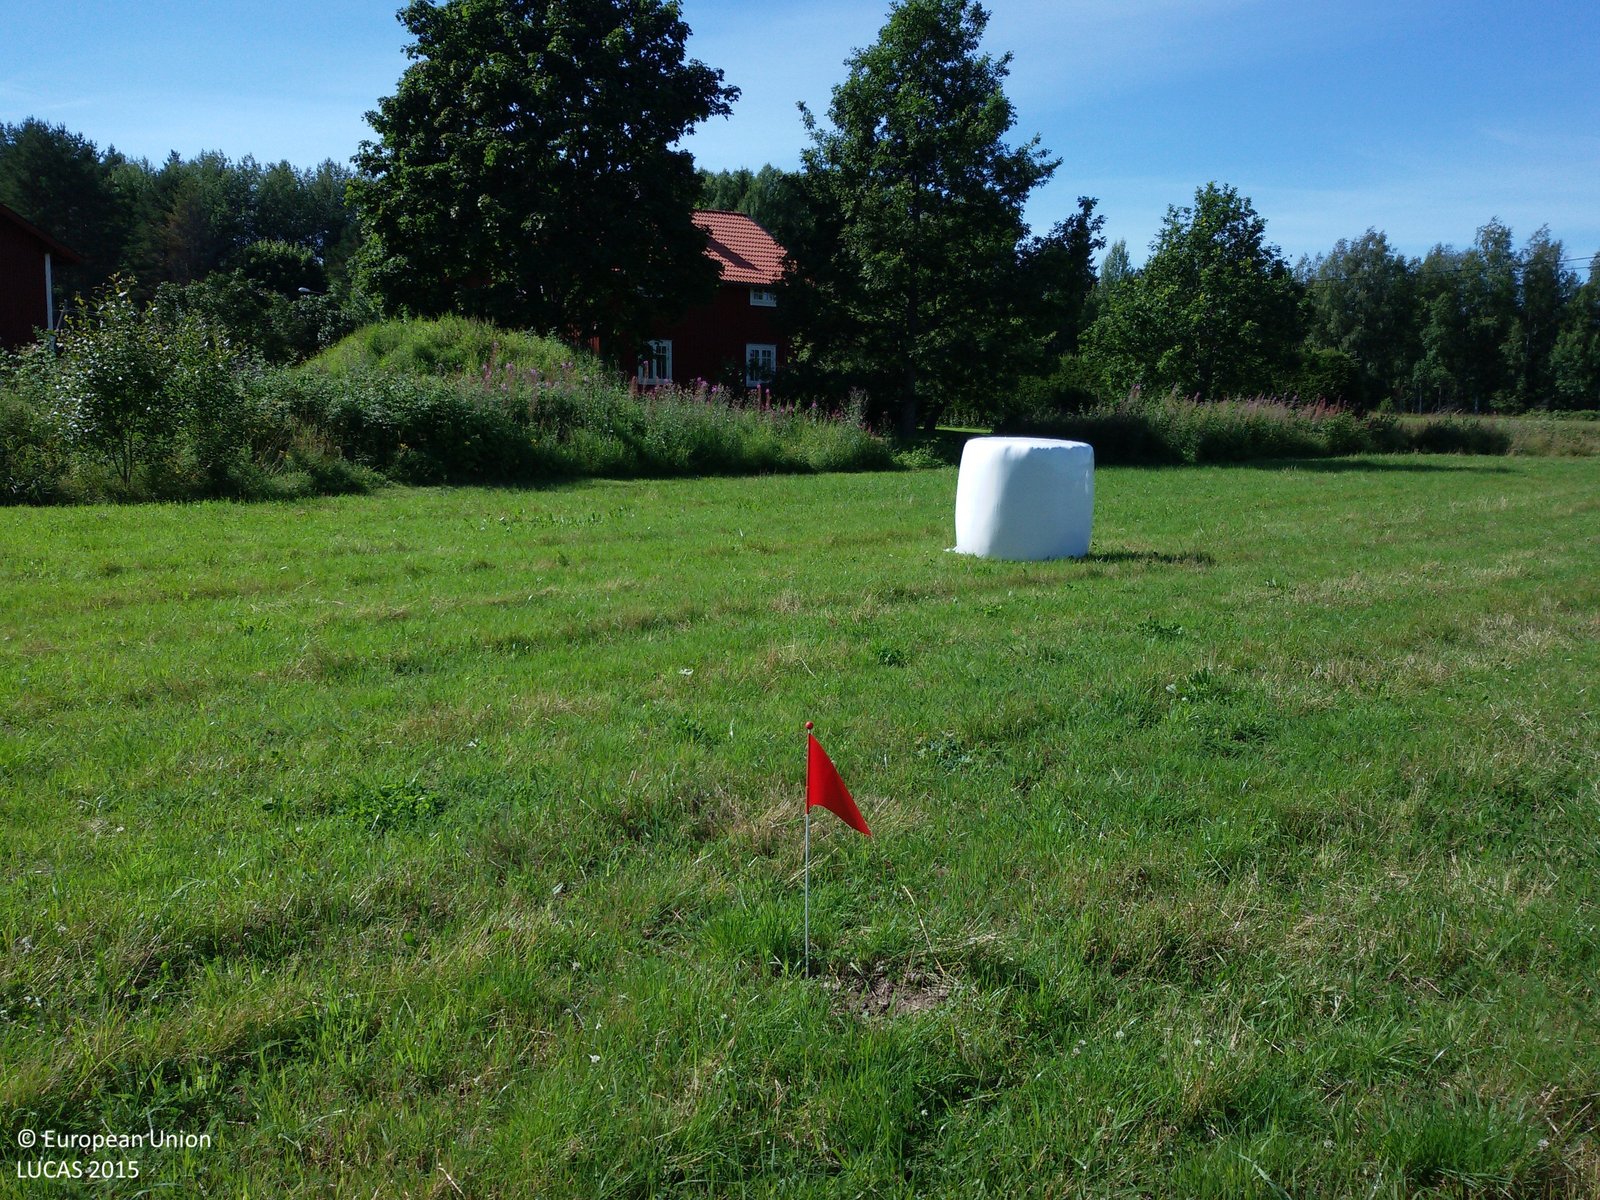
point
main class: Grassland
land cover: Grassland without tree/shrub cover
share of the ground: > 75 %
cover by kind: herbaceous plants 100 %
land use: Agriculture (excluding fallow land and kitchen gardens)
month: August
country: SE
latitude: 60.9557
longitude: 16.4308
